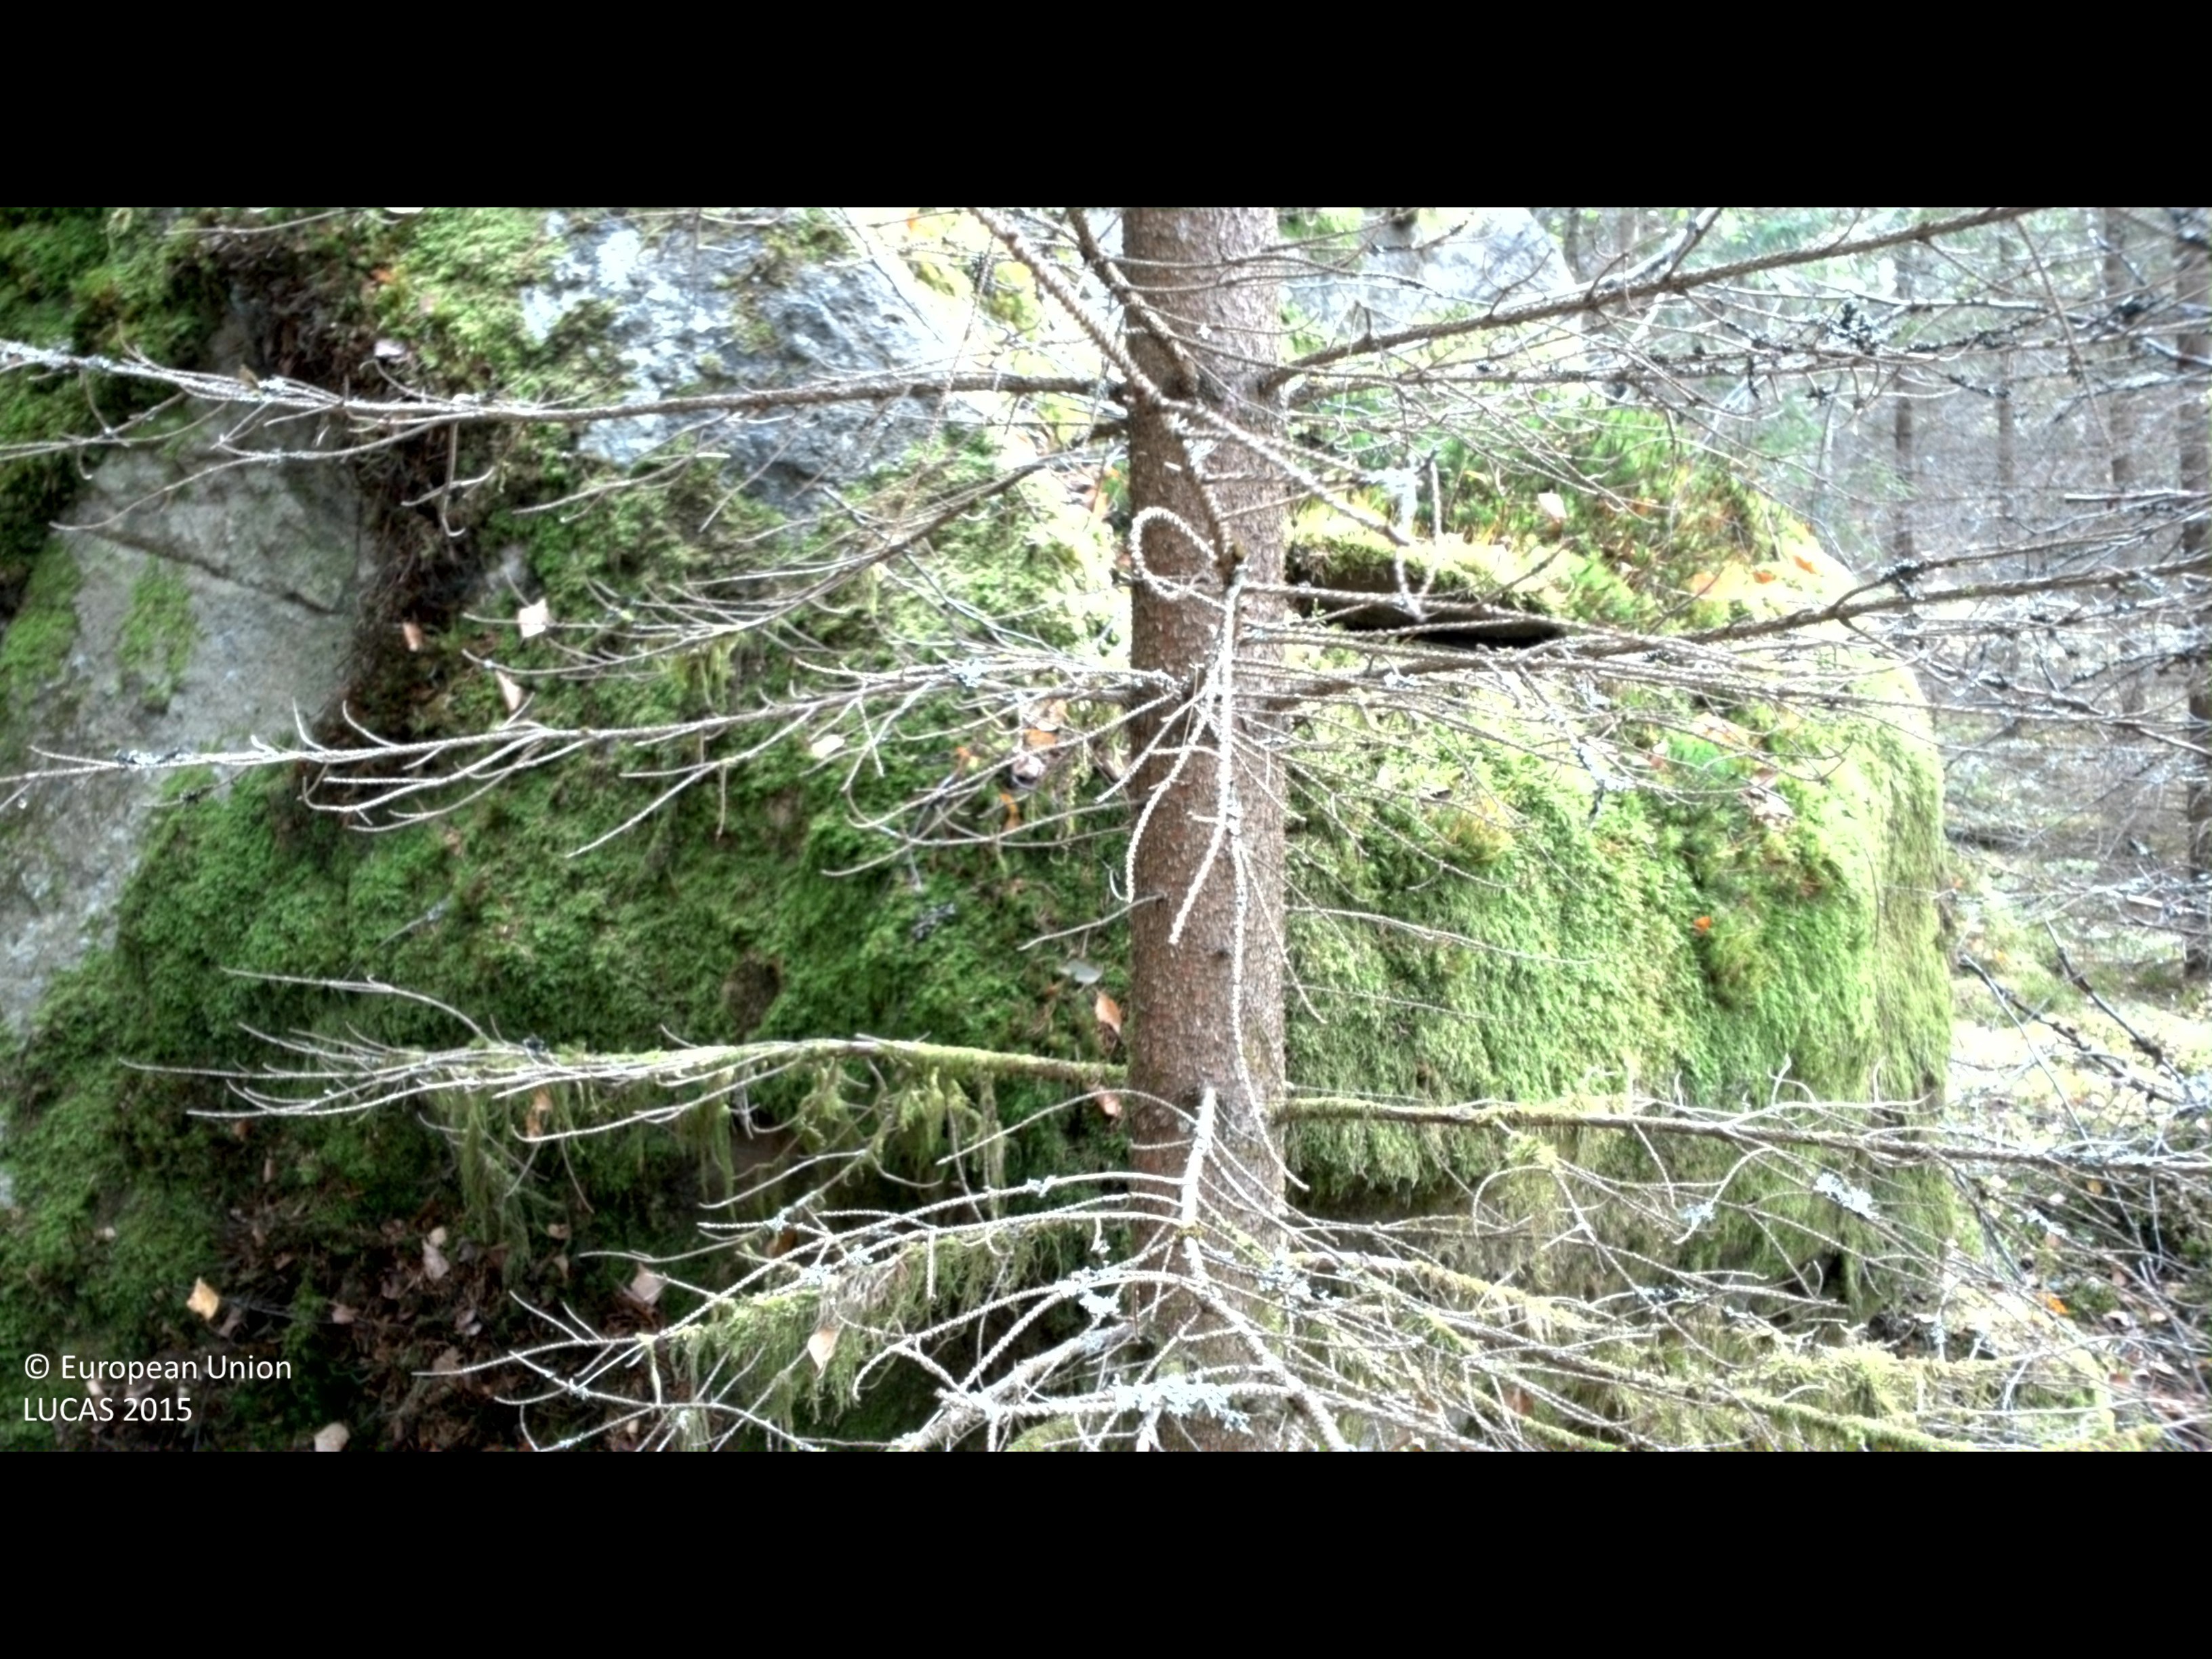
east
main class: Woodland
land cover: Spruce dominated coniferous woodland
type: boreal forest
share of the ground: > 75 %
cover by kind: coniferous forest trees 85 %, broadleaved forest trees 5 %, shrubs 5 %, lichens and mosses 5 %
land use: Forestry
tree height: > 5 m
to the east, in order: Spruce dominated coniferous woodland; Spruce dominated mixed woodland; Shrubland with sparse tree cover; Inland fresh water bodies; Shrubland with sparse tree cover; Groves; Spruce dominated coniferous woodland
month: August
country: SE
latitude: 56.3280
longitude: 14.4127
